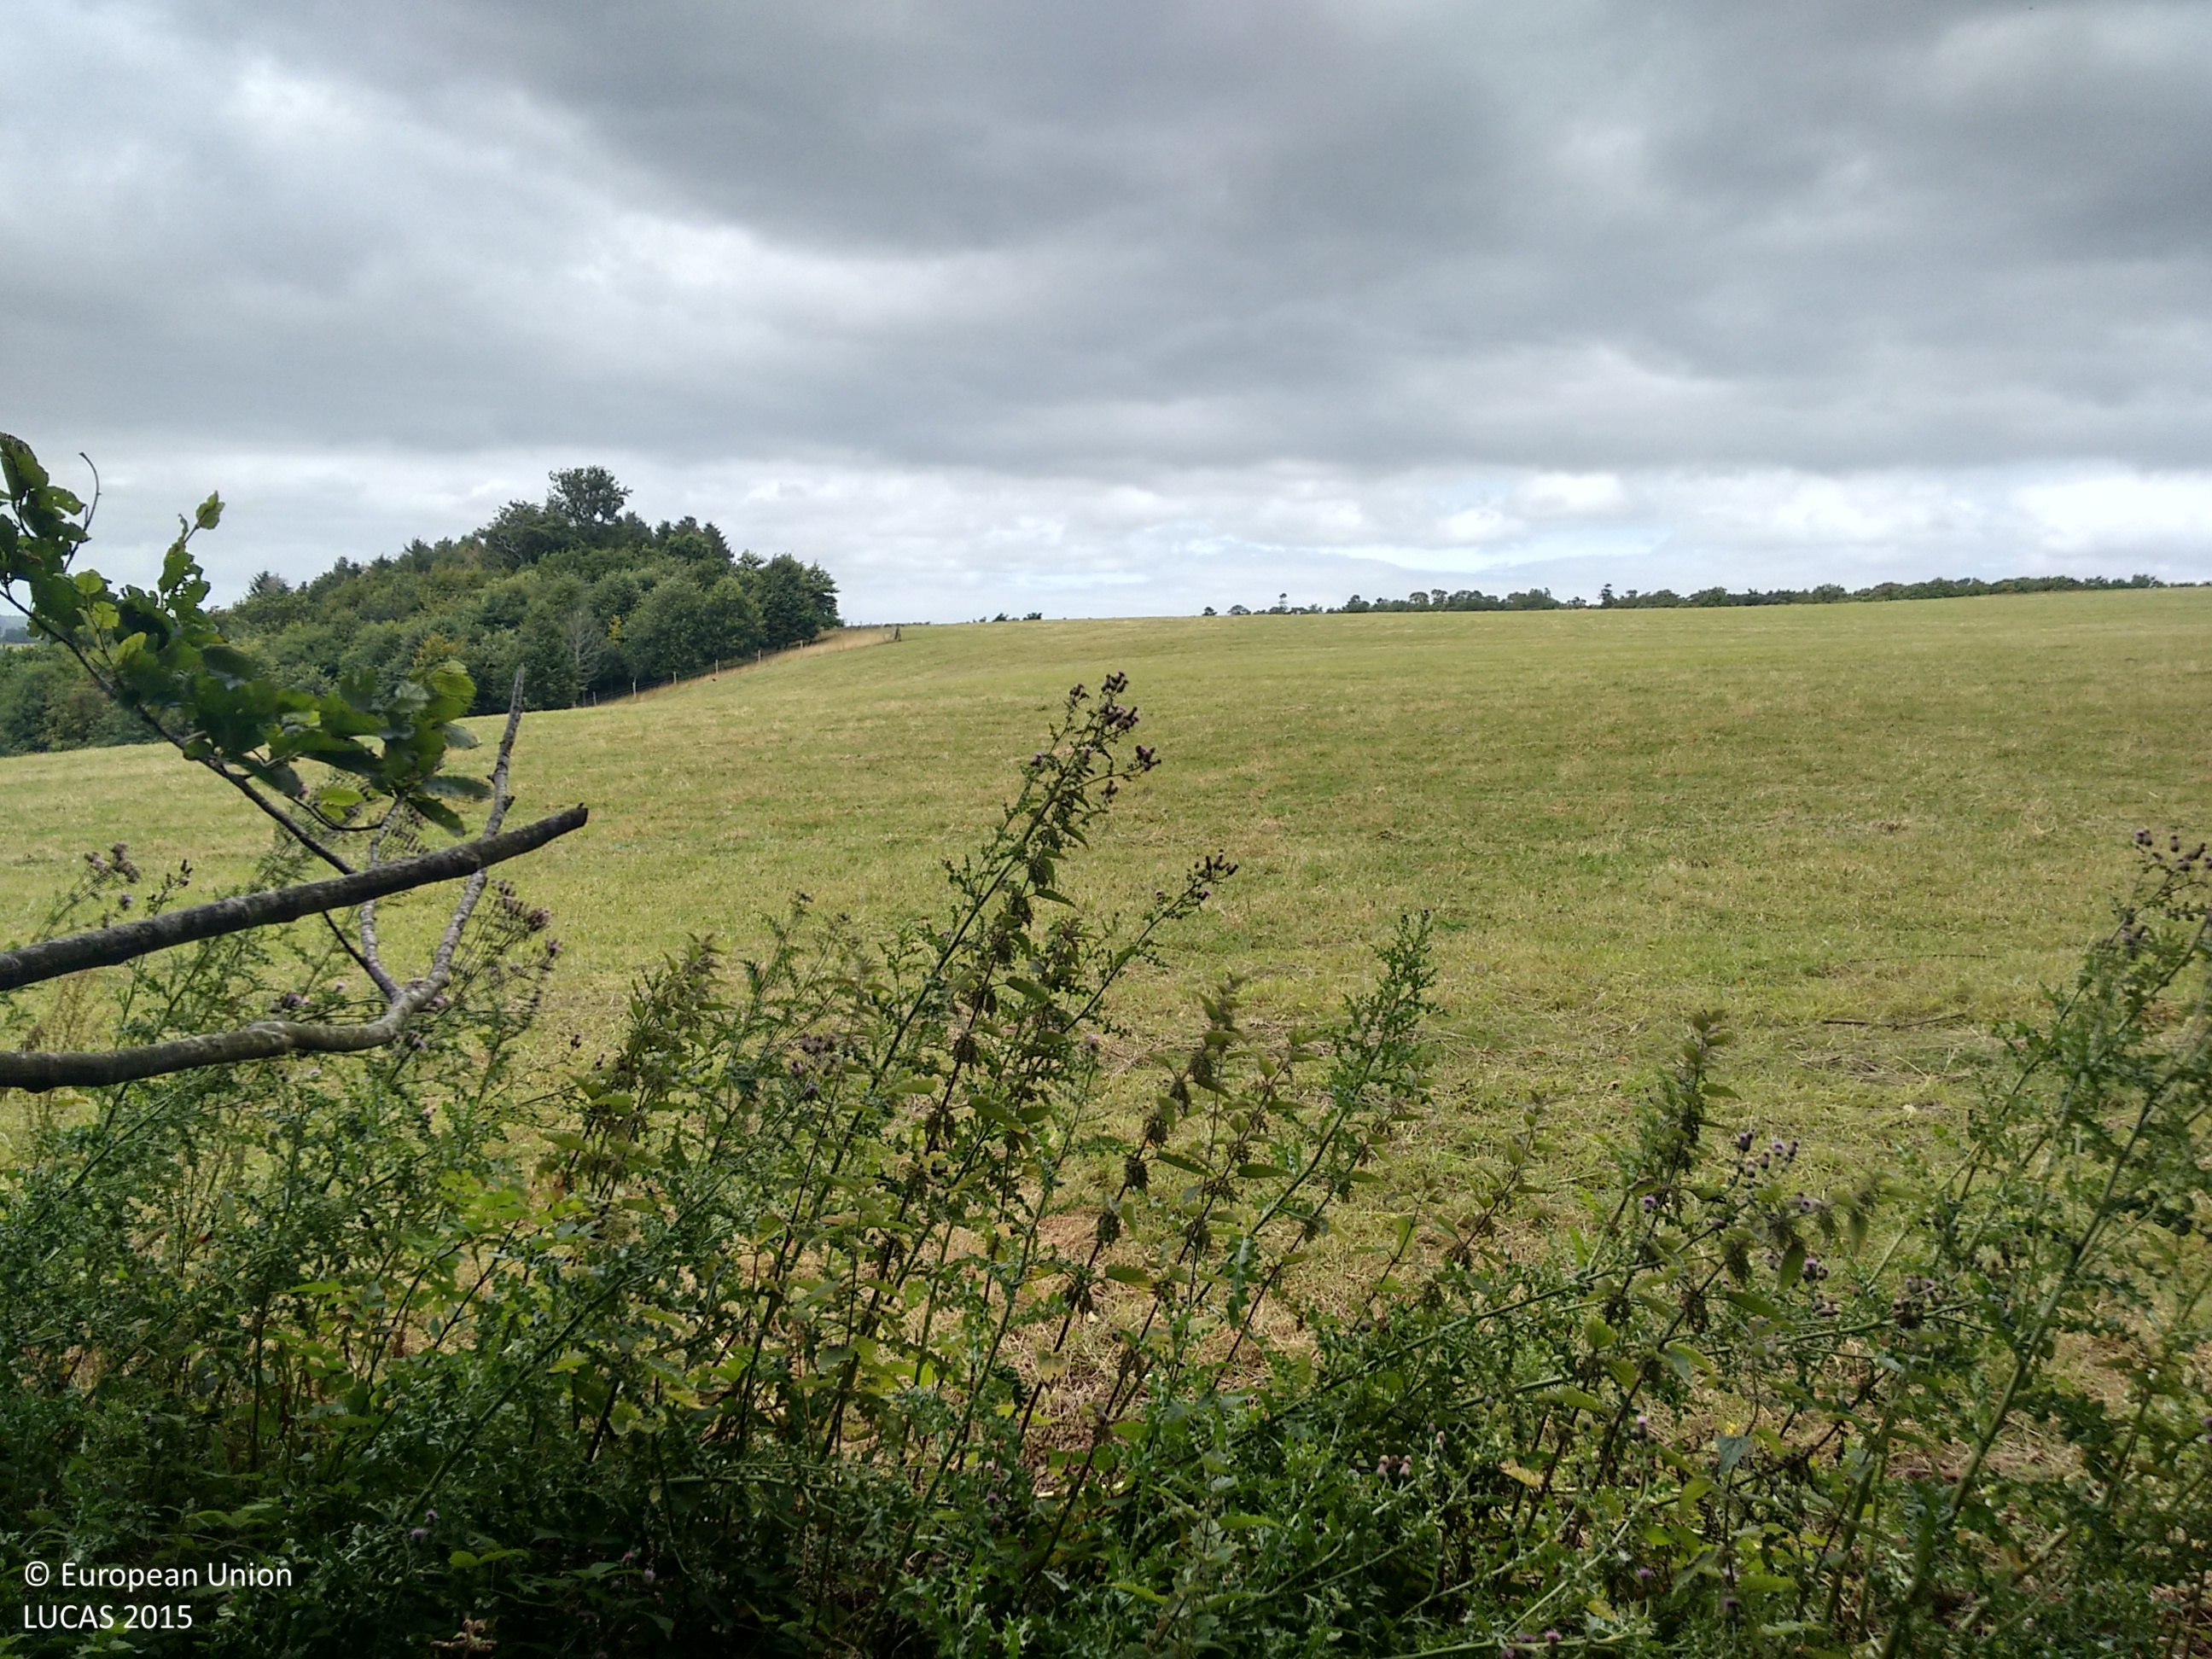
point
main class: Grassland
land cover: Grassland without tree/shrub cover
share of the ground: > 75 %
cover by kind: herbaceous plants 100 %
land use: Agriculture (excluding fallow land and kitchen gardens)
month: August
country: GB
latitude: 50.5896
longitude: -3.5747
